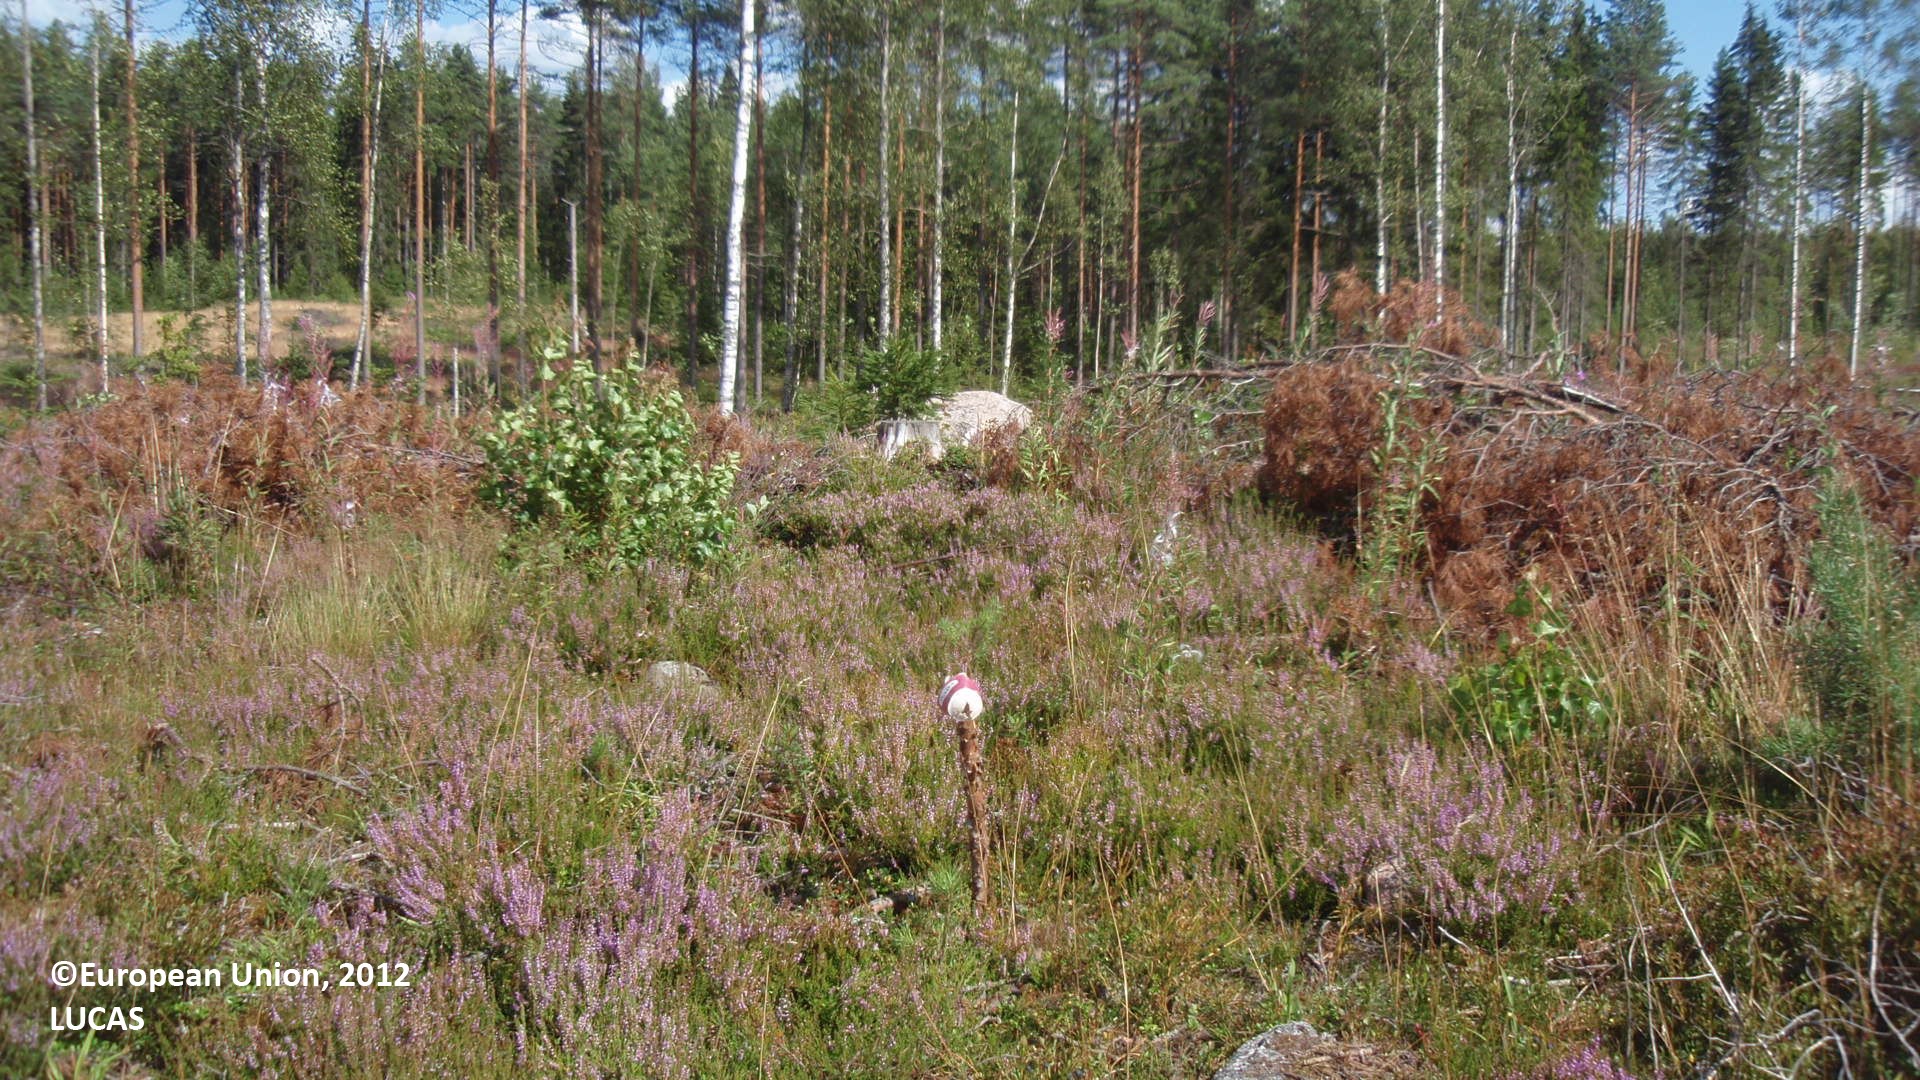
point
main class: Shrubland
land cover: Shrubland with sparse tree cover
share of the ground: 50 - 75 %
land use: Forestry
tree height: < 5 m
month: August
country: FI
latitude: 61.0492
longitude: 27.8422
